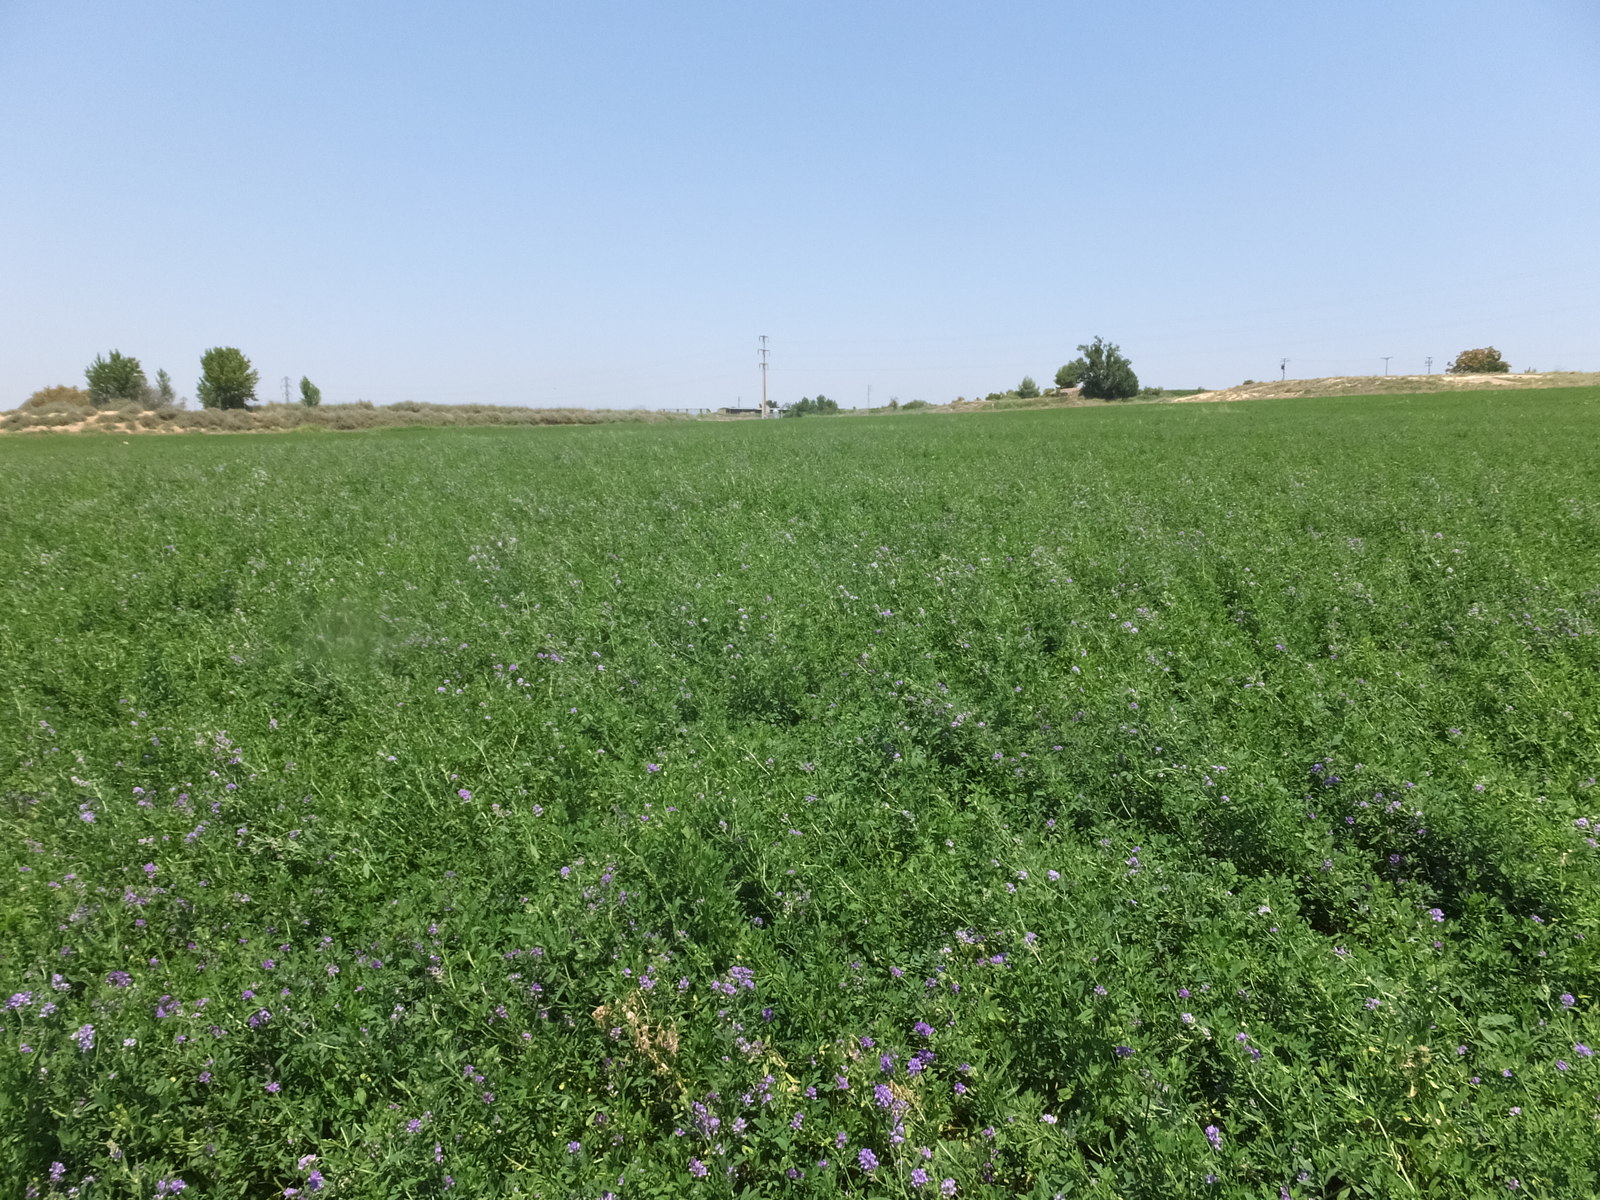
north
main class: Cropland
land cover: Lucerne
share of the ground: > 75 %
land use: Agriculture (excluding fallow land and kitchen gardens)
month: June
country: ES
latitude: 41.7965
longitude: 0.3936
